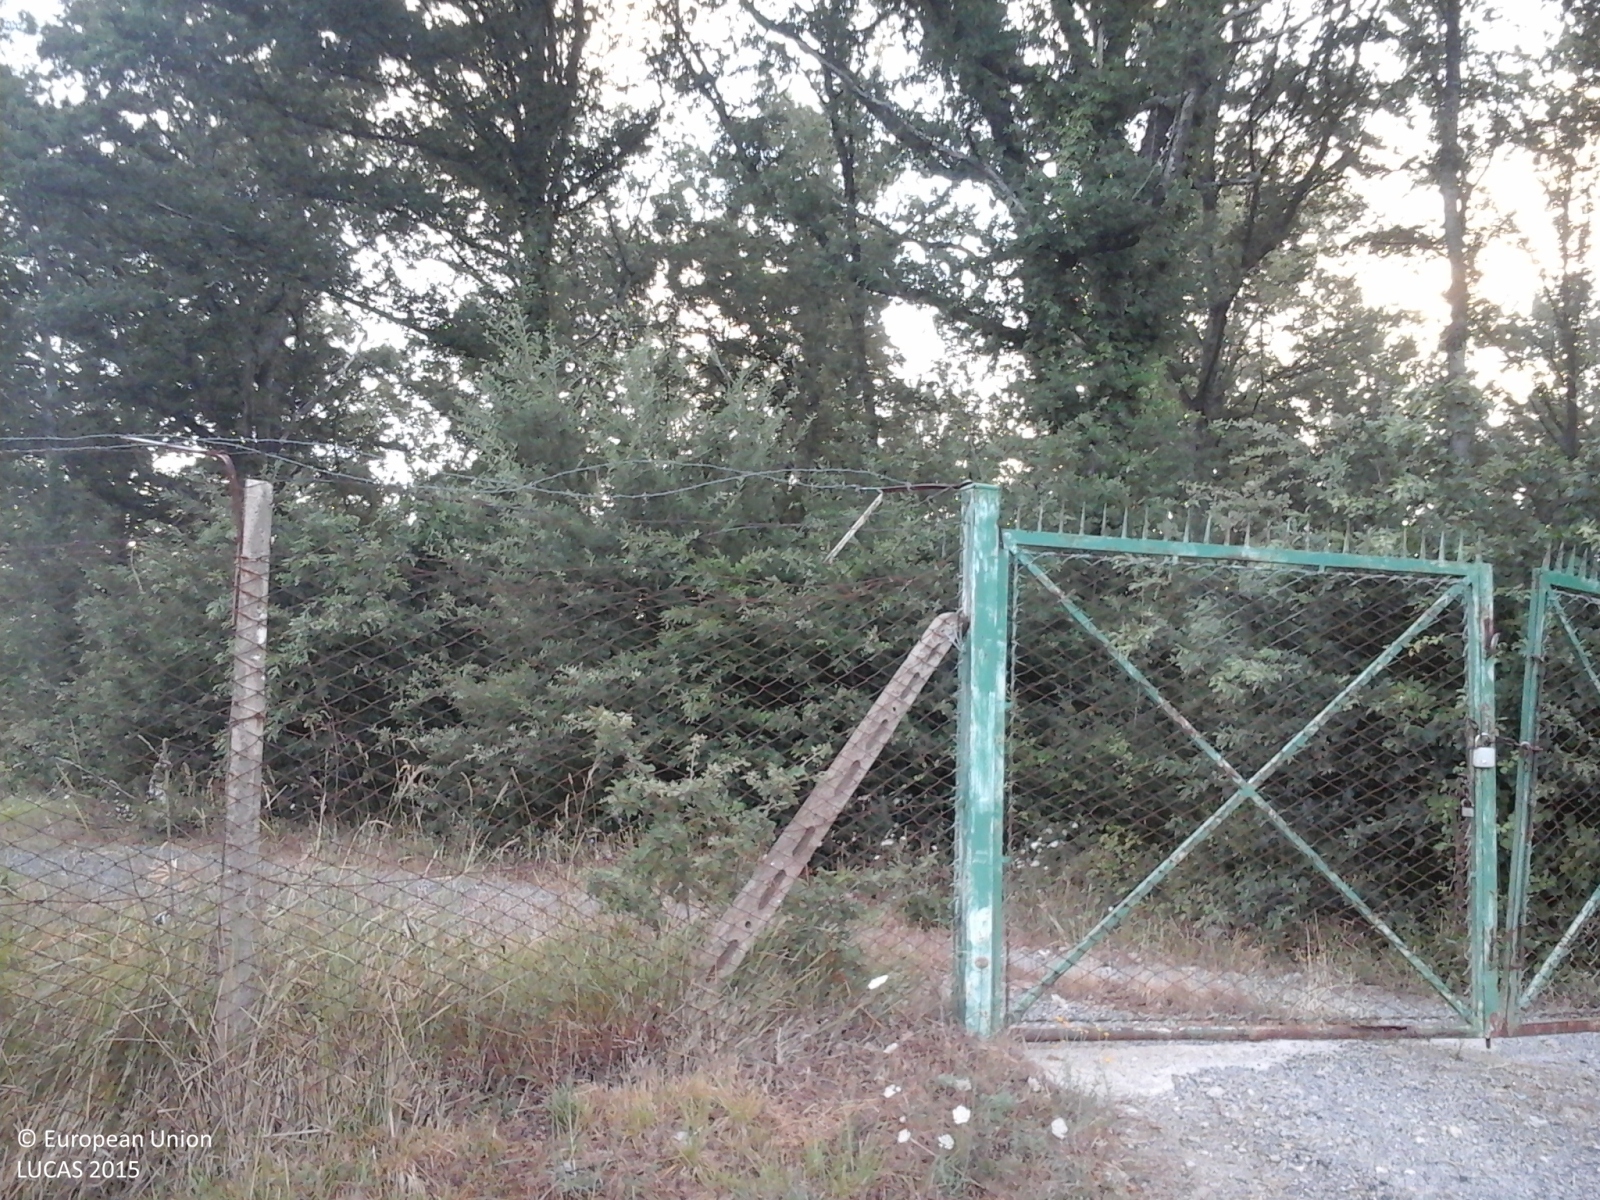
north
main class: Woodland
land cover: Broadleaved woodland
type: thermophilous deciduous forest
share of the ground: > 75 %
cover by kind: broadleaved forest trees 100 %
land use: Forestry
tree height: > 5 m
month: July
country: IT
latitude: 43.4438
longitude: 10.9734
